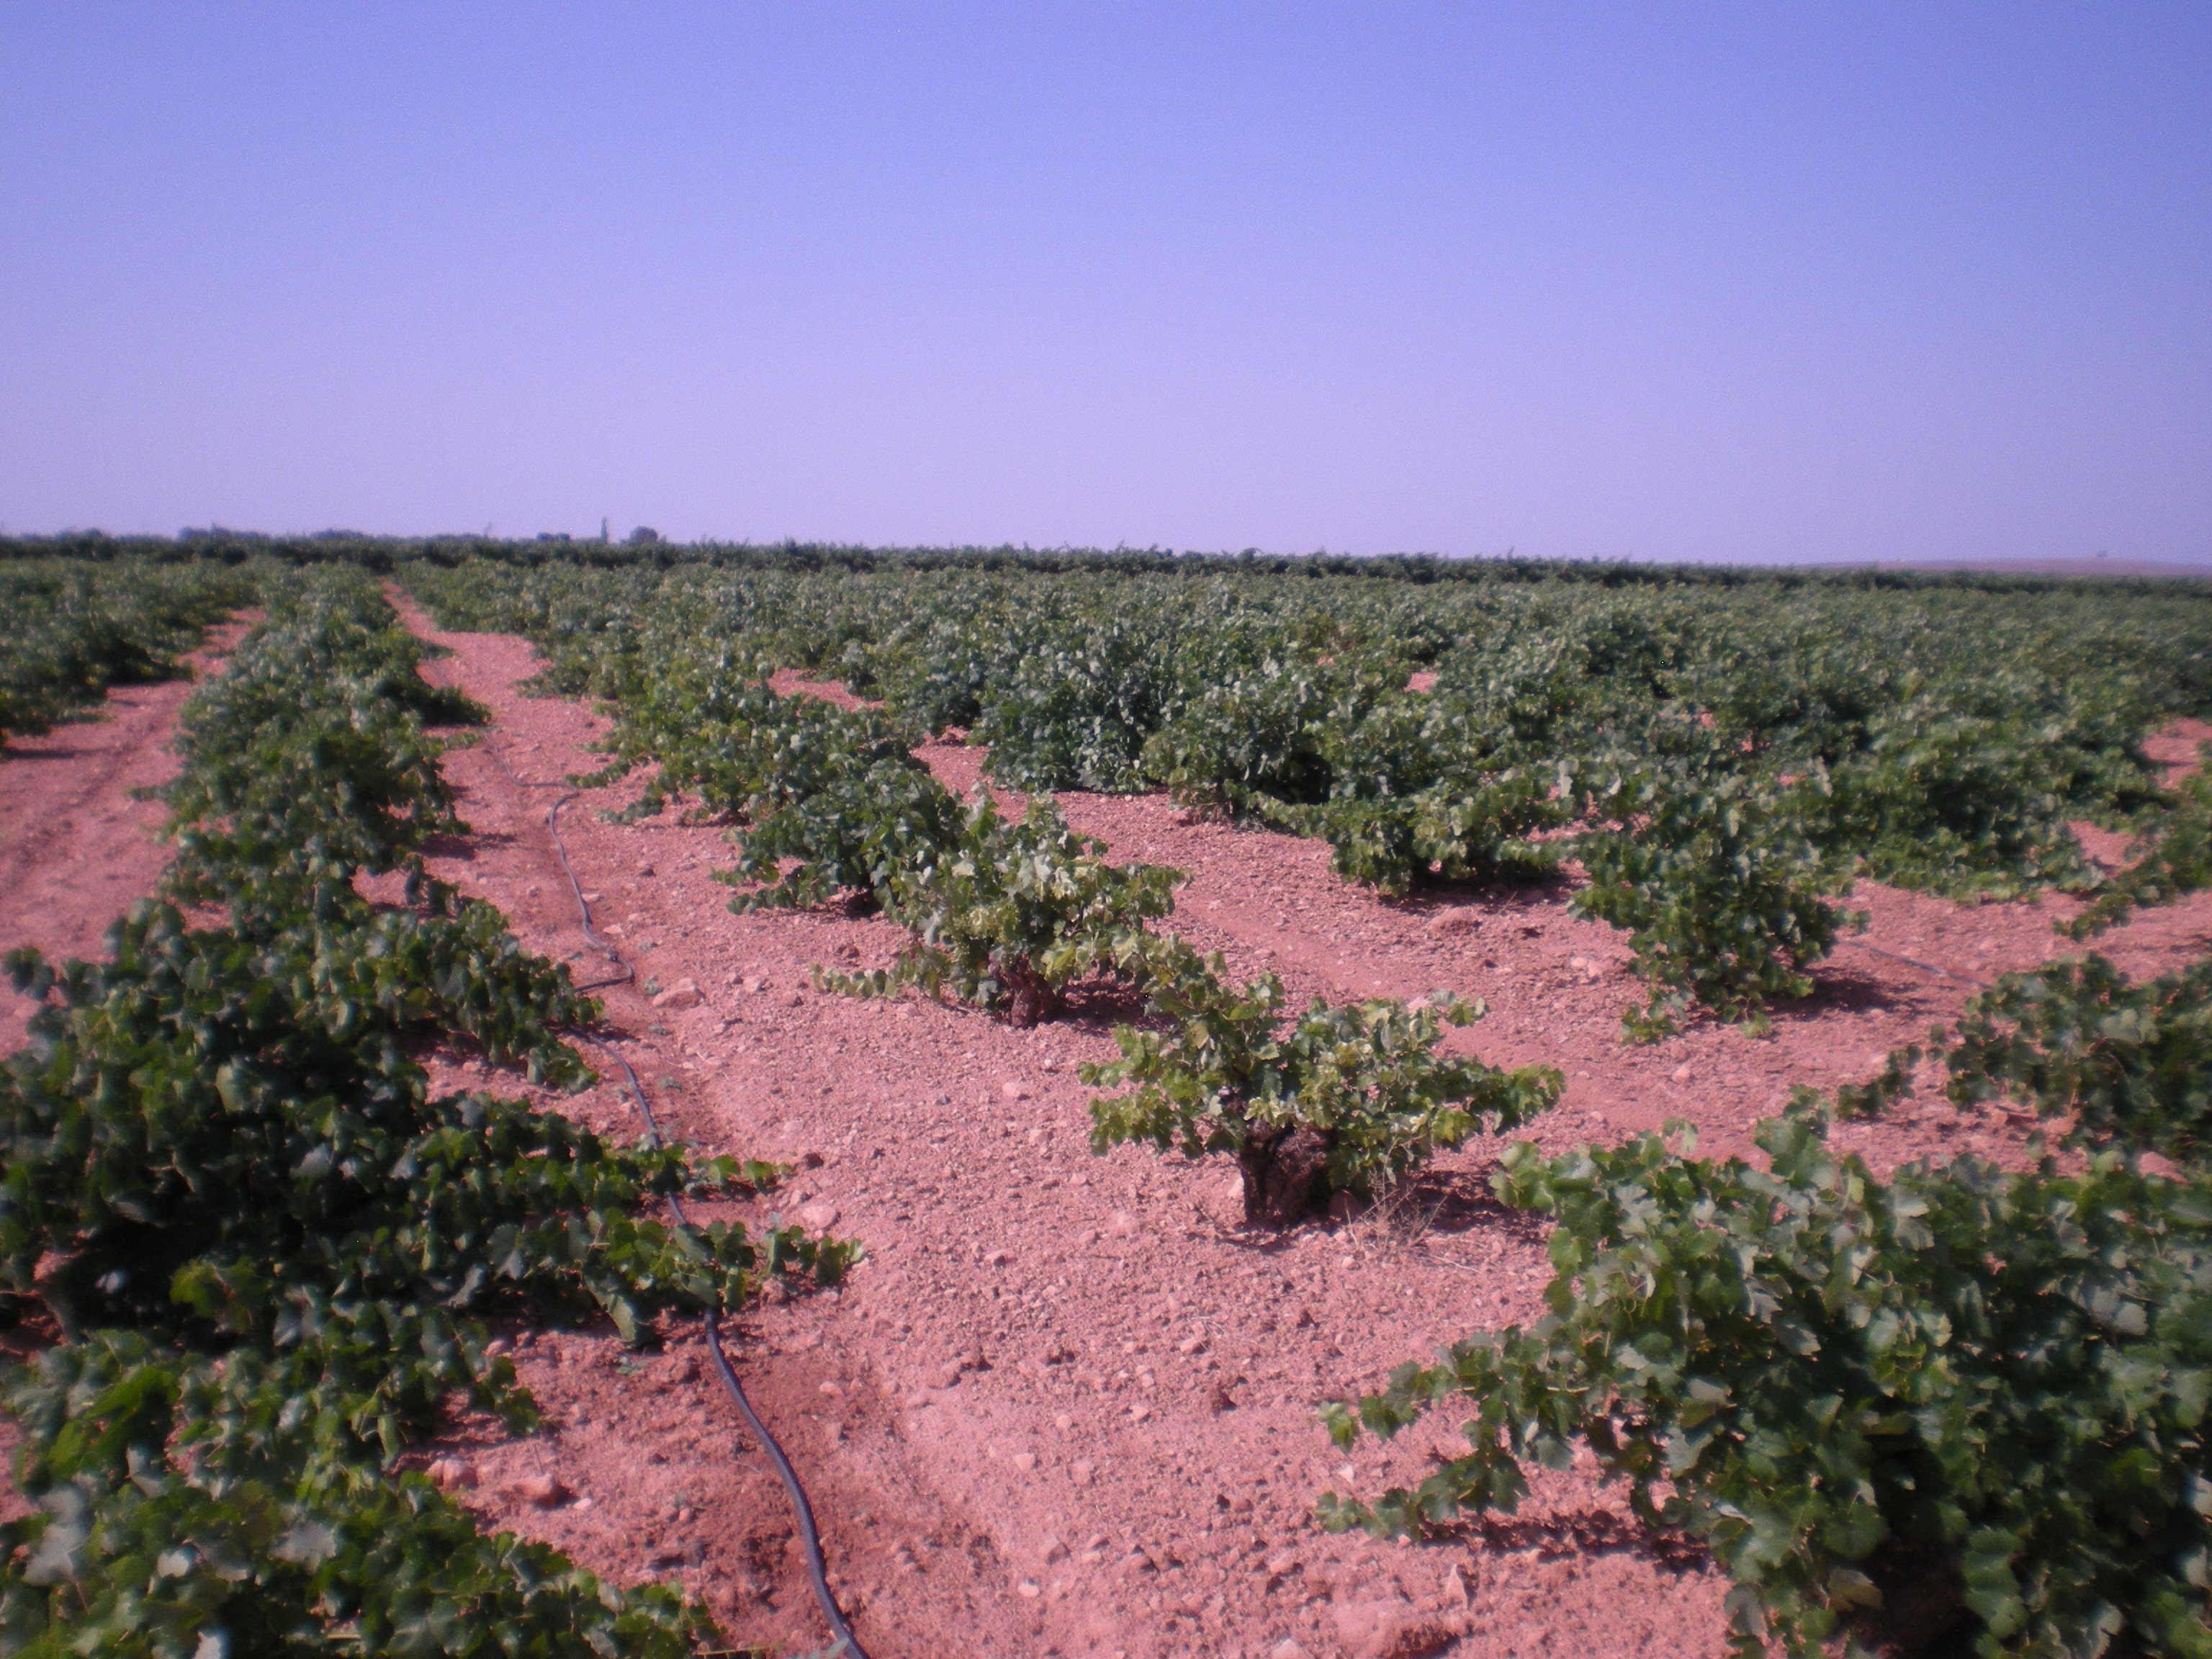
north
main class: Cropland
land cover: Vineyards
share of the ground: 25 - 50 %
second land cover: Other bare soil
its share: > 75 %
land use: Agriculture (excluding fallow land and kitchen gardens)
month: July
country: ES
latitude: 39.4296
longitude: -3.0395
